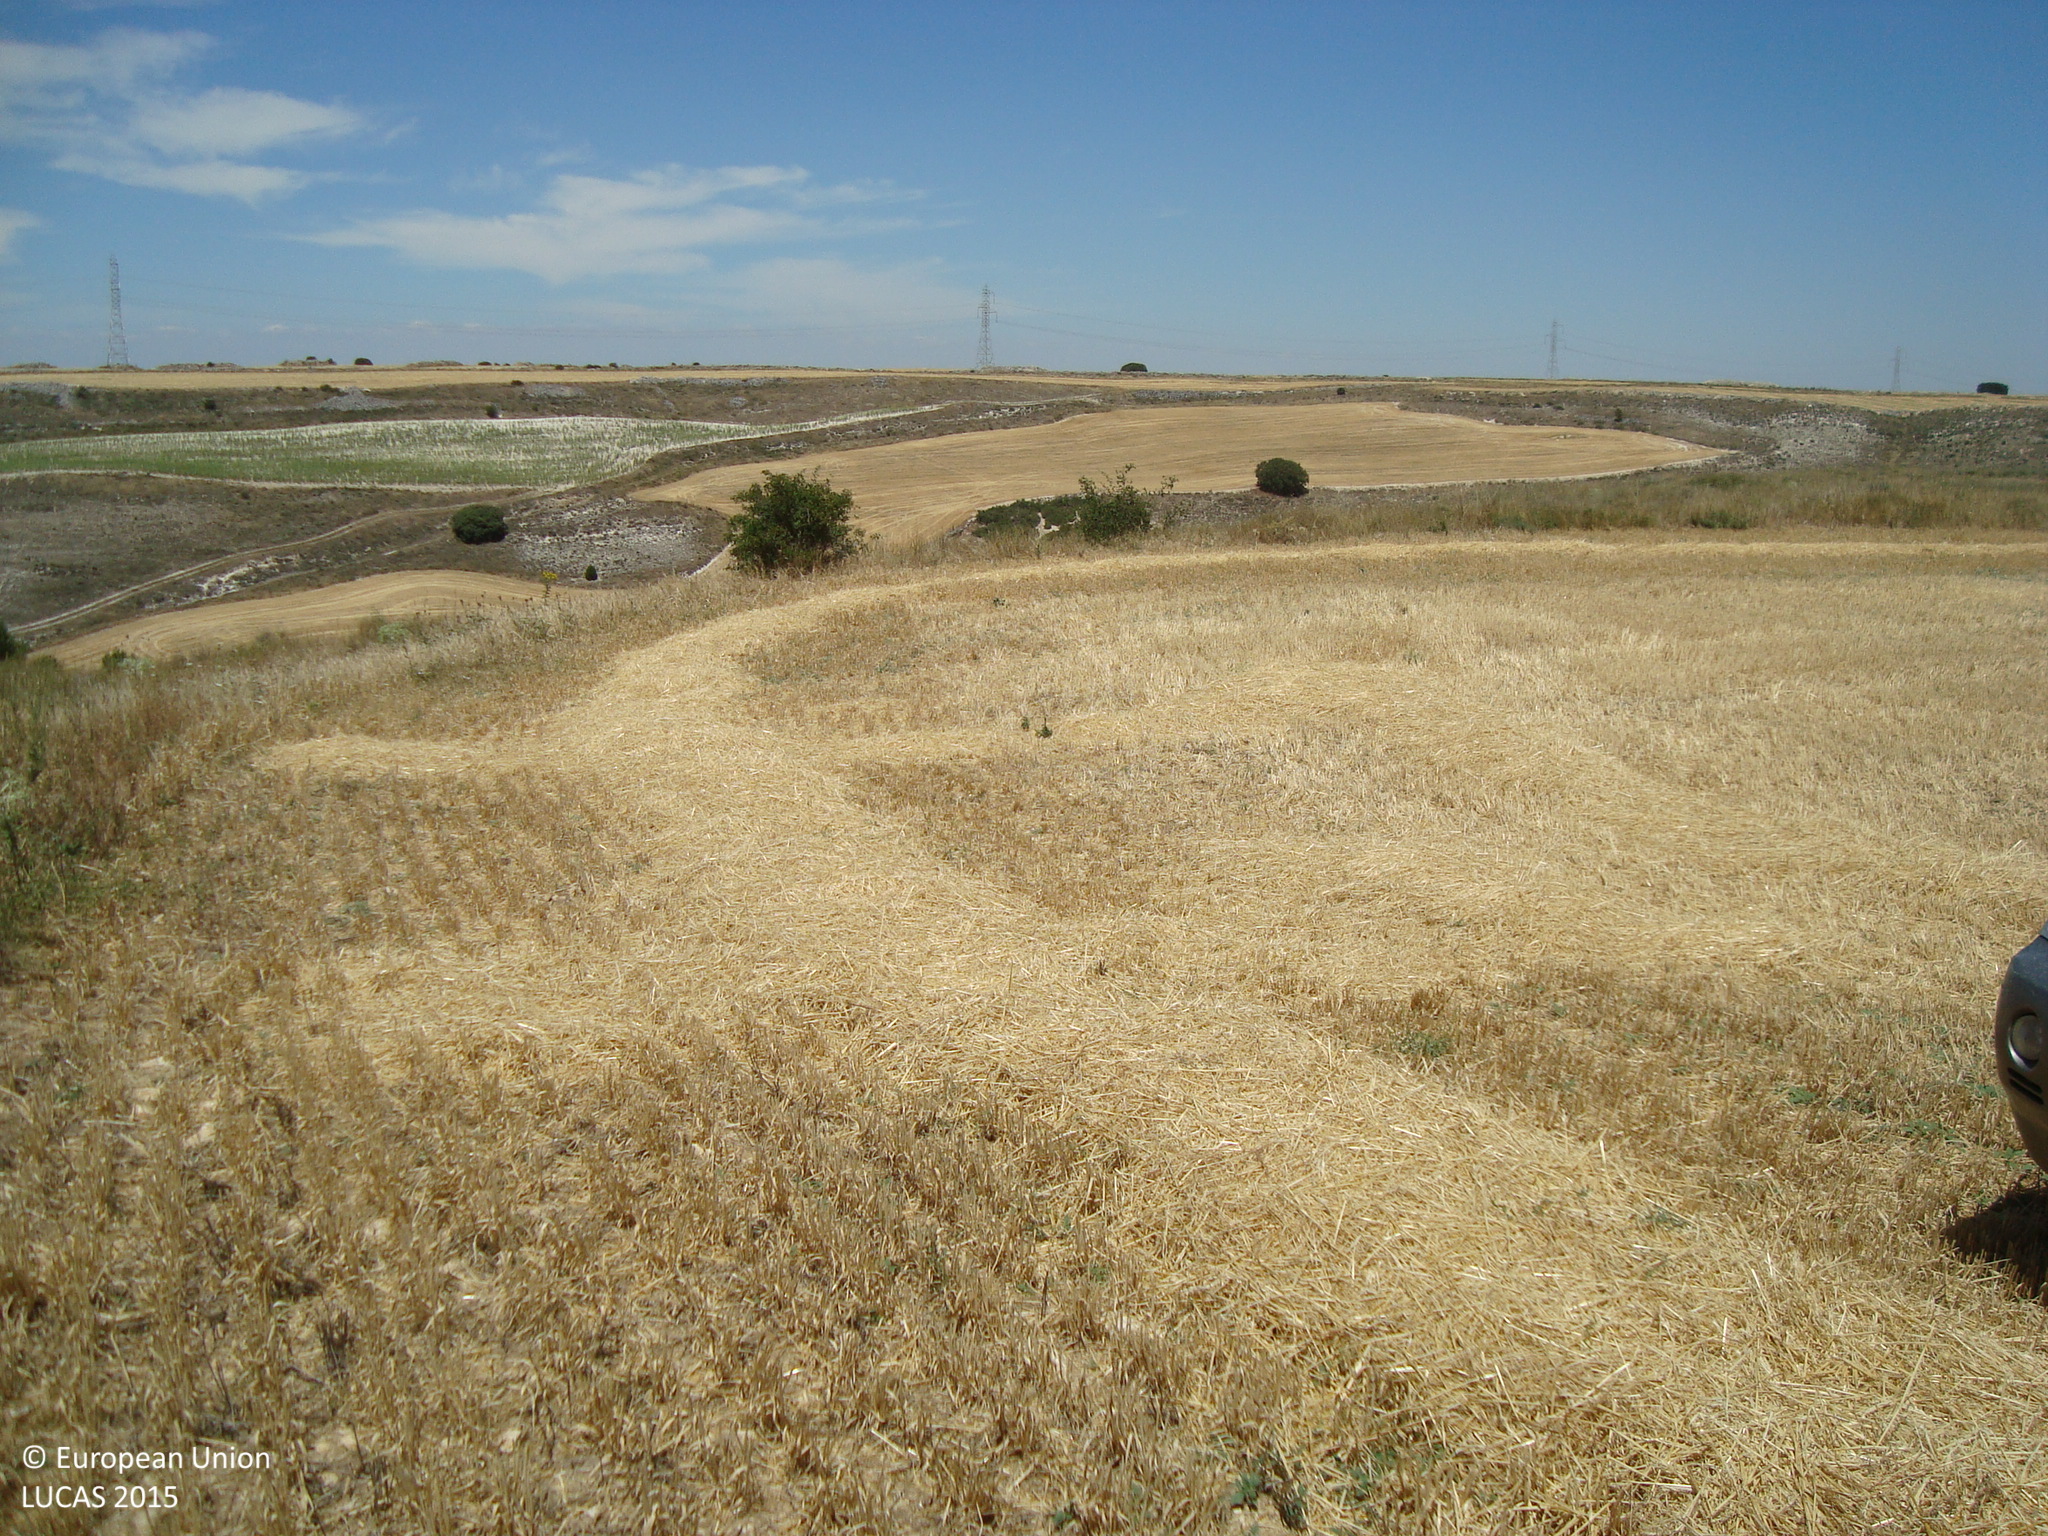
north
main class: Cropland
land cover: Barley
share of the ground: > 75 %
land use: Agriculture (excluding fallow land and kitchen gardens)
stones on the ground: 25 - 50 %
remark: Harvested field
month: July
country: ES
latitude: 42.0378
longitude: -4.1616
